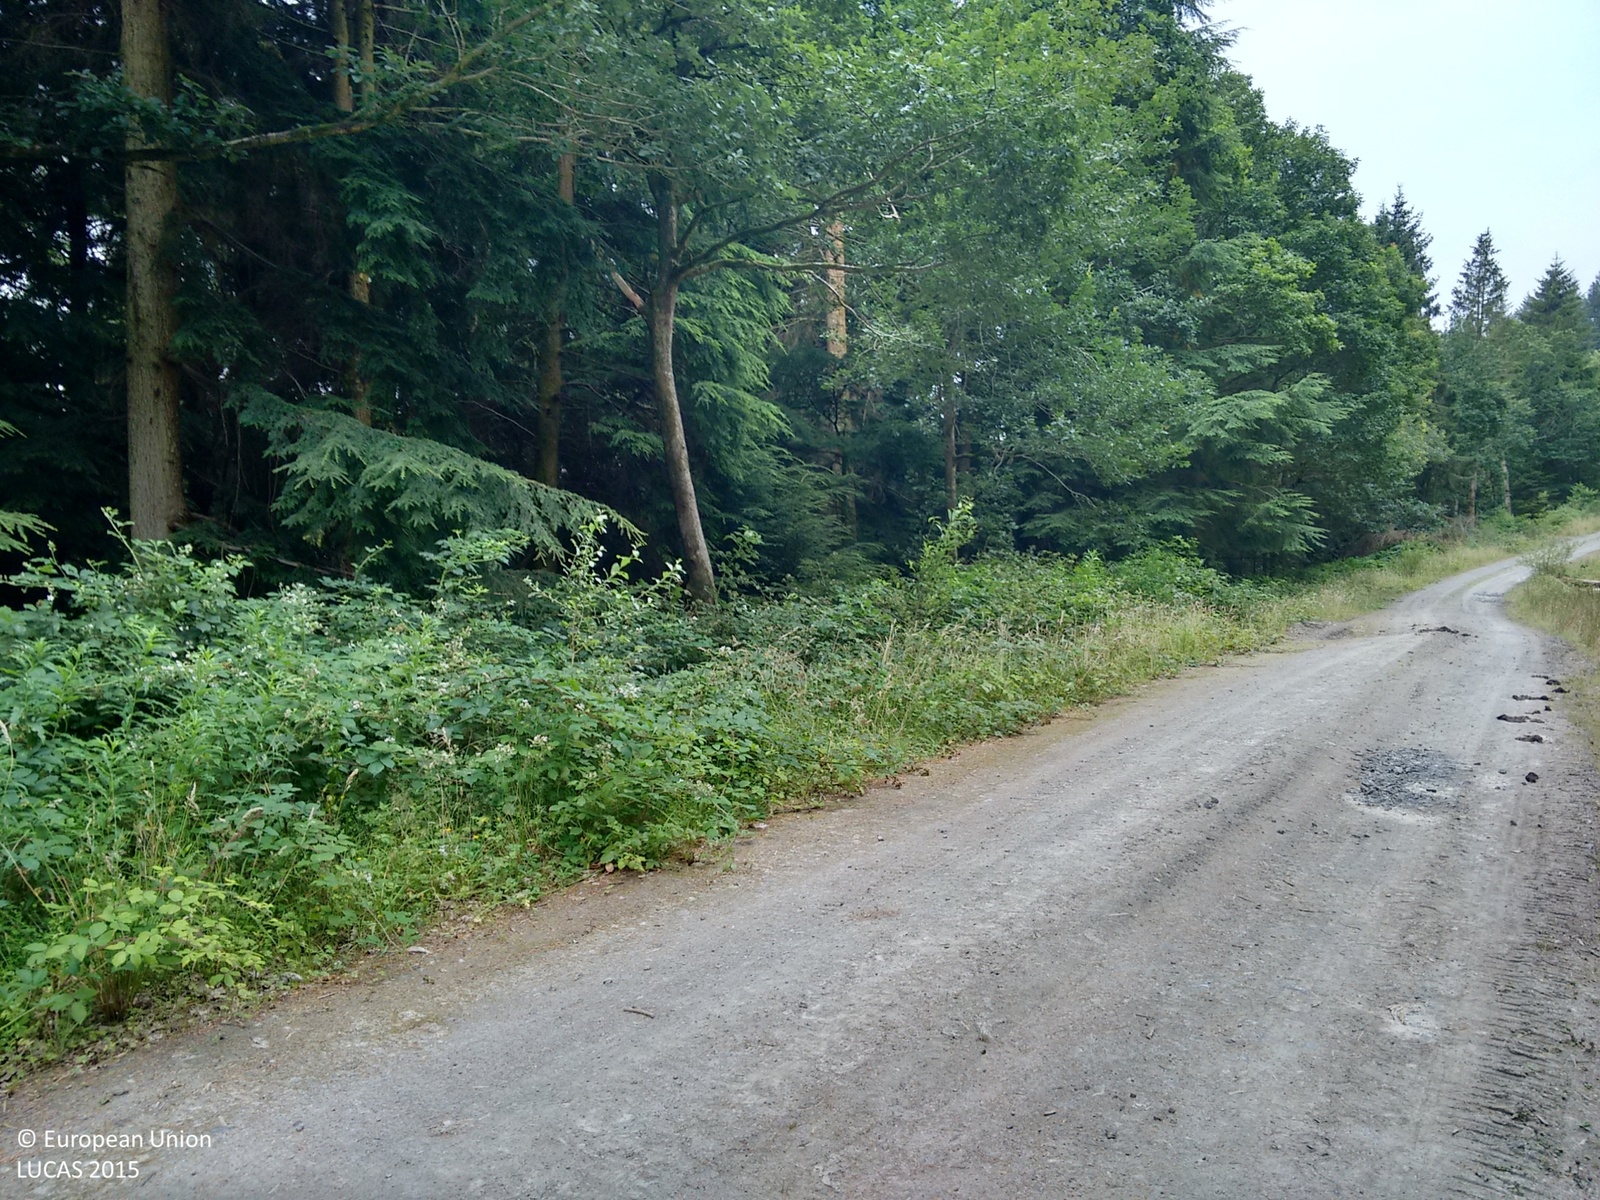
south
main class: Woodland
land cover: Spruce dominated coniferous woodland
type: exotic forest
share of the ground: > 75 %
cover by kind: coniferous forest trees 90 %, shrubs 10 %
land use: Forestry
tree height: > 5 m
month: August
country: GB
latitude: 52.0789
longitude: -3.9407
